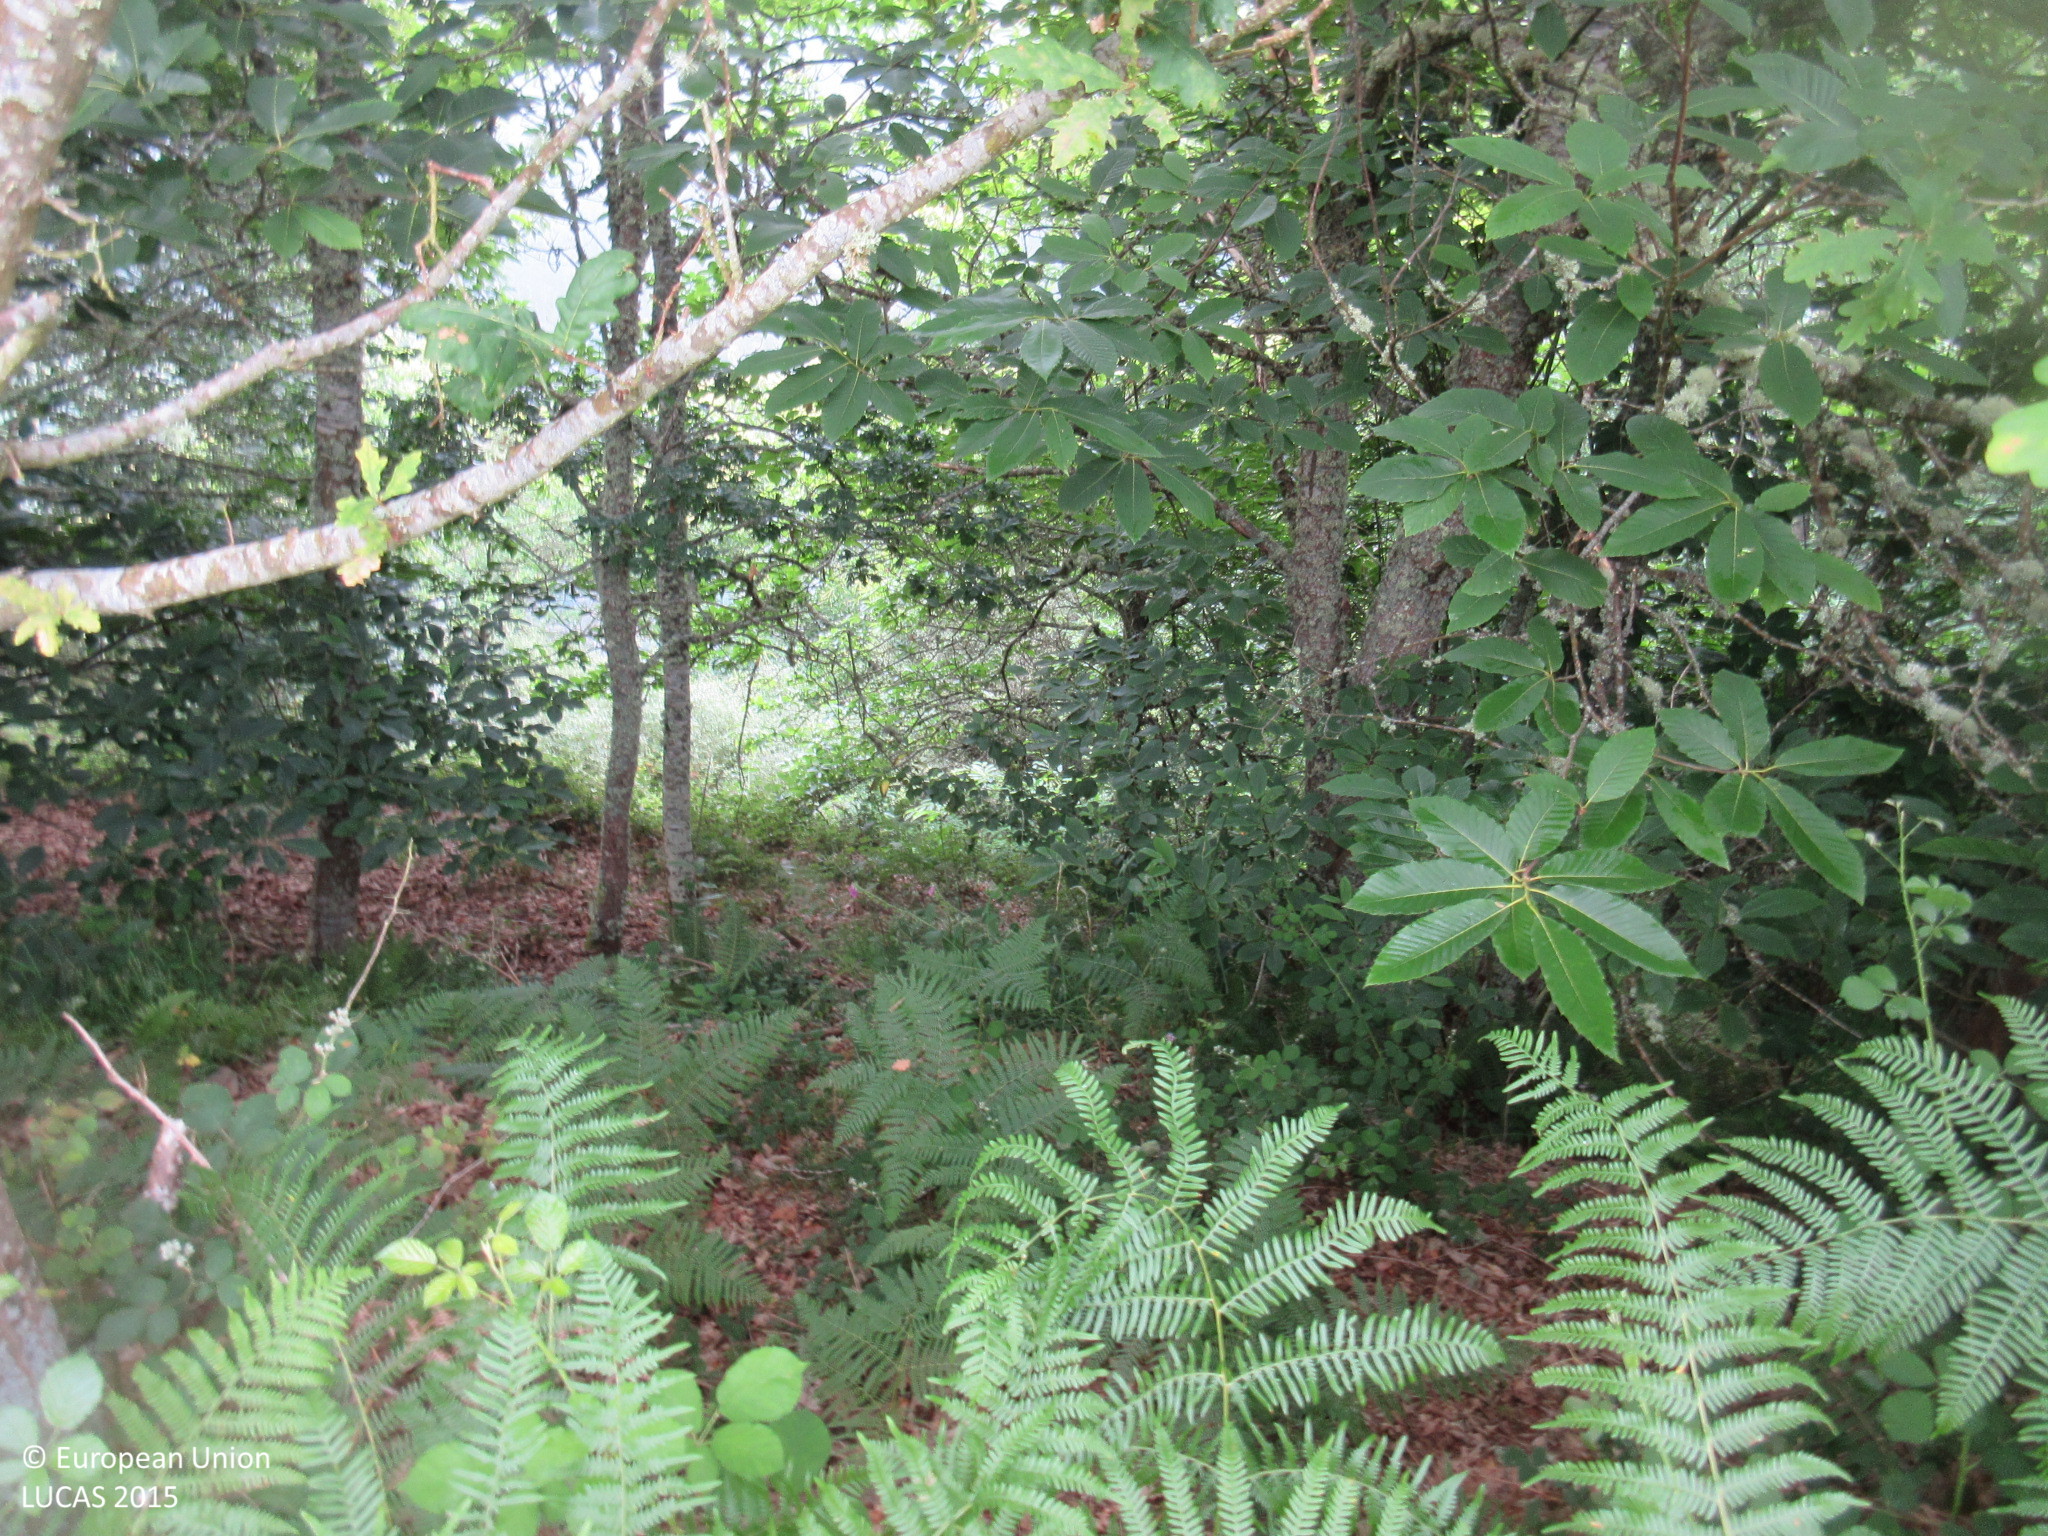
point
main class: Woodland
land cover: Broadleaved woodland
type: acidophilous oak and oak-birch forest
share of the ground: > 75 %
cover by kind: broadleaved forest trees 95 %, shrubs 5 %
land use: Semi-natural and natural areas not in use
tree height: > 5 m
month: June
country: ES
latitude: 43.2036
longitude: -6.9364
